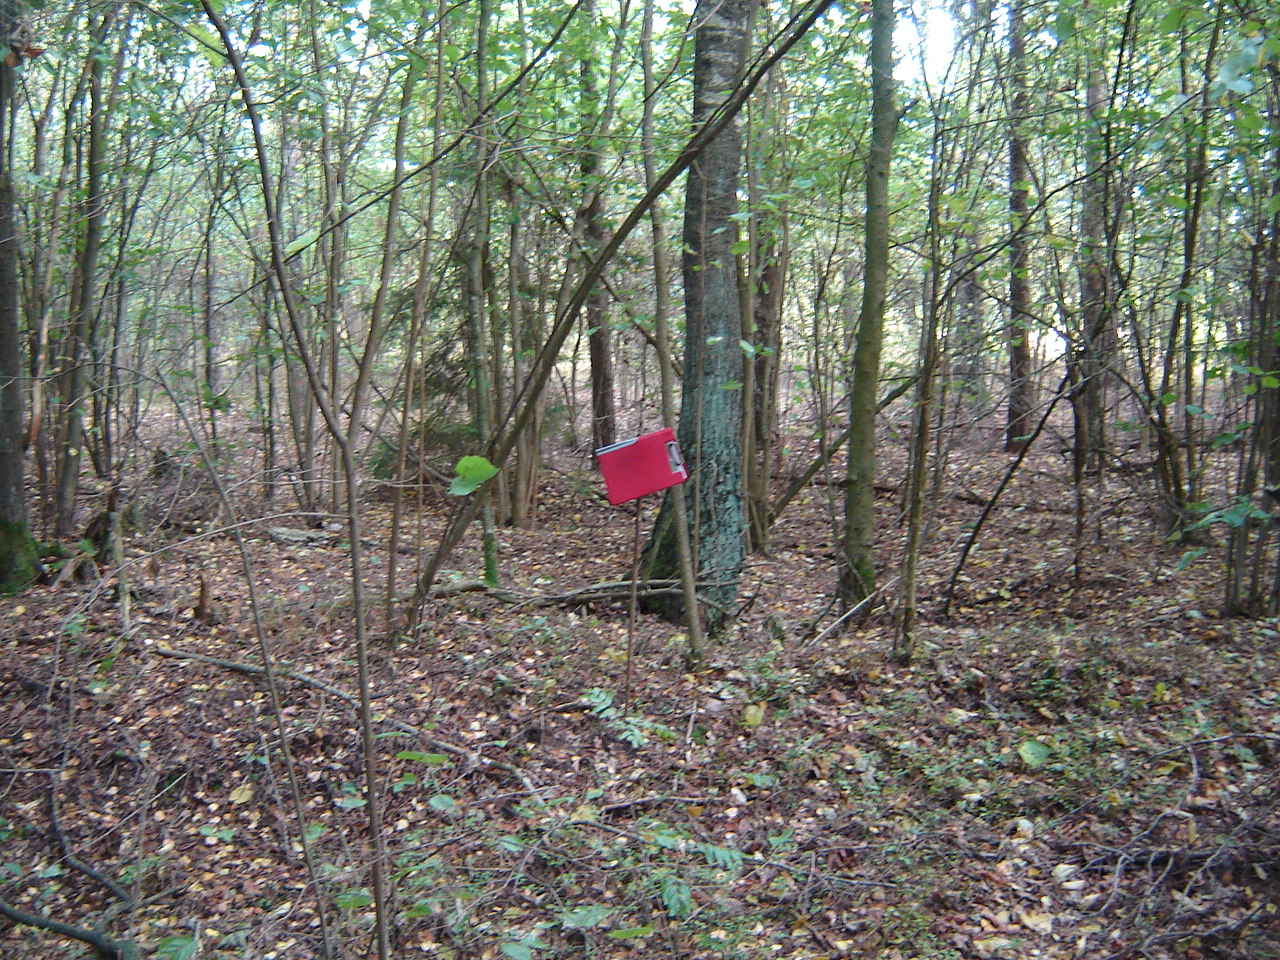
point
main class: Woodland
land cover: Pine dominated mixed woodland
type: hemiboreal forest and nemoral coniferous forest and mixed broadleaved-coniferous forest
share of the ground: > 75 %
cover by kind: broadleaved forest trees 50 %, coniferous forest trees 40 %, herbaceous plants 5 %, unconsolidated bare surface 5 %
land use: Forestry
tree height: > 5 m
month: September
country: LT
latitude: 54.1958
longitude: 25.0300
